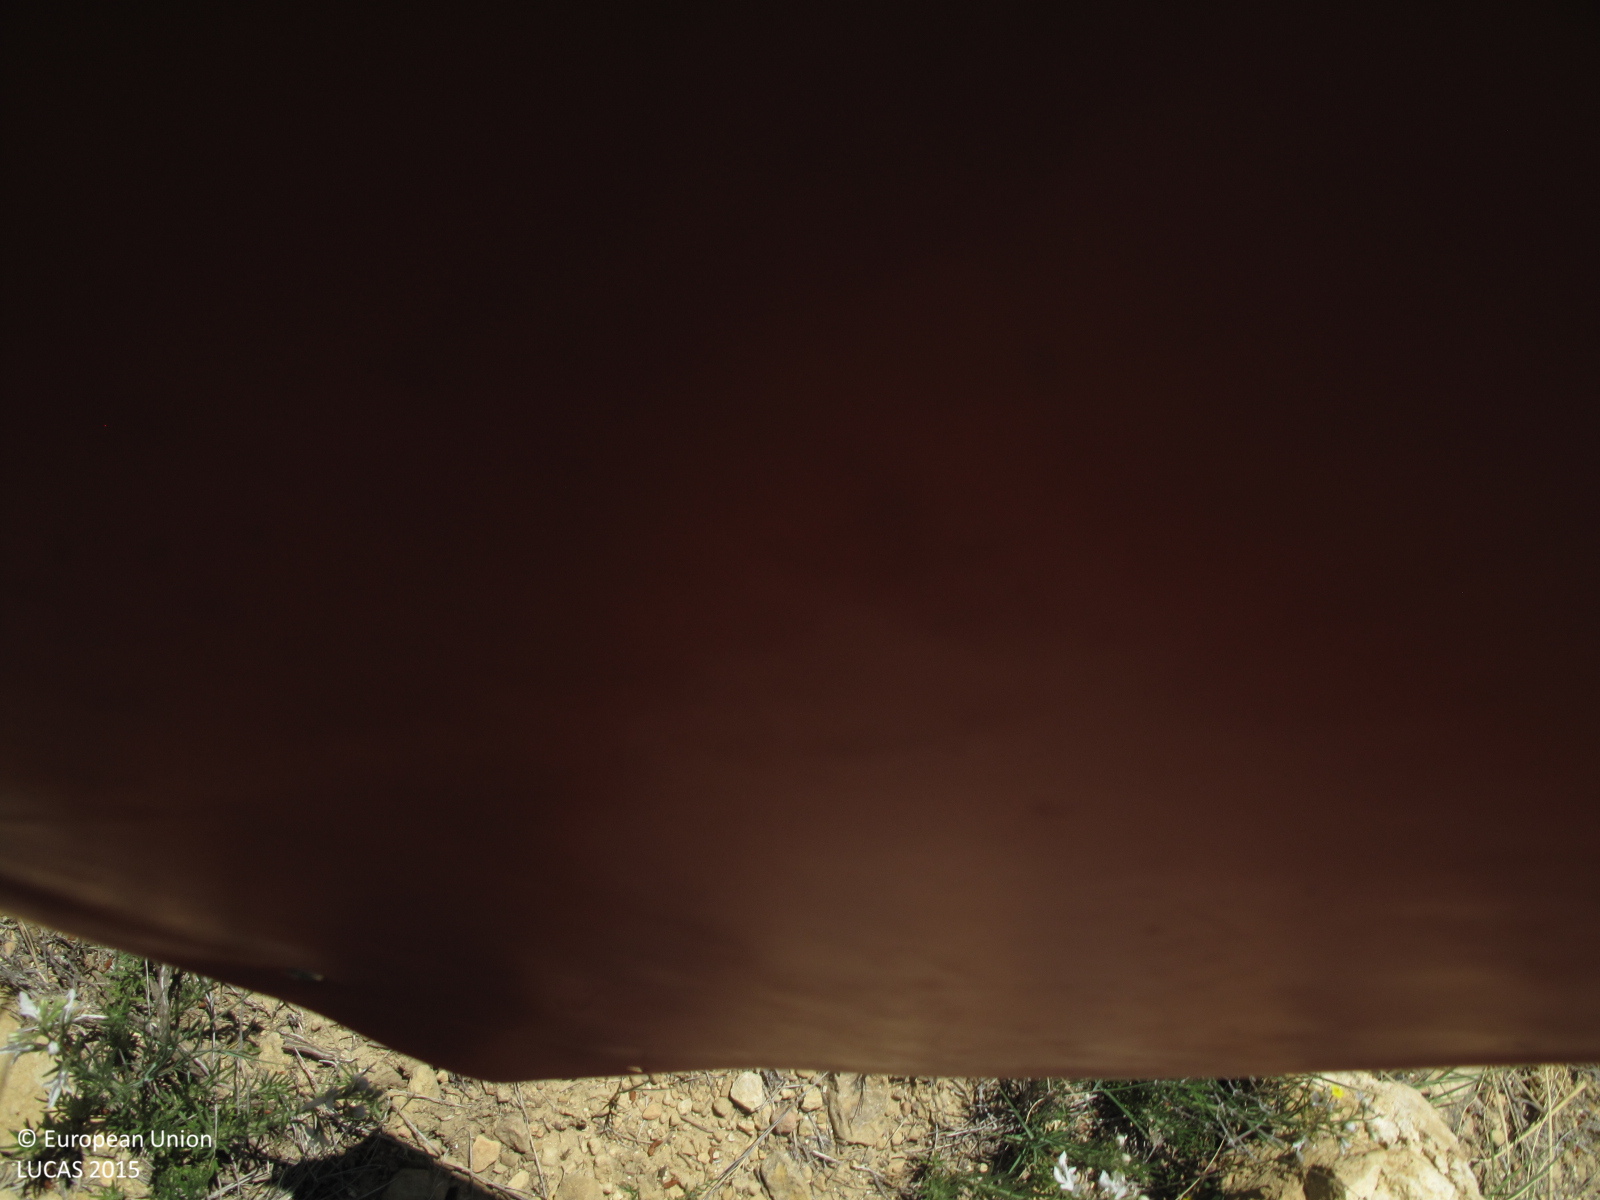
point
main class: Woodland
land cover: Pine dominated coniferous woodland
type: coniferous forest of the mediterranean region
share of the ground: 25 - 50 %
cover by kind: coniferous forest trees 40 %, shrubs 20 %, herbaceous plants 20 %, consolidated bare surface 20 %
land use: Semi-natural and natural areas not in use
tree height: > 5 m
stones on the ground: 25 - 50 %
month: May
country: ES
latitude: 38.8646
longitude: -0.9766
